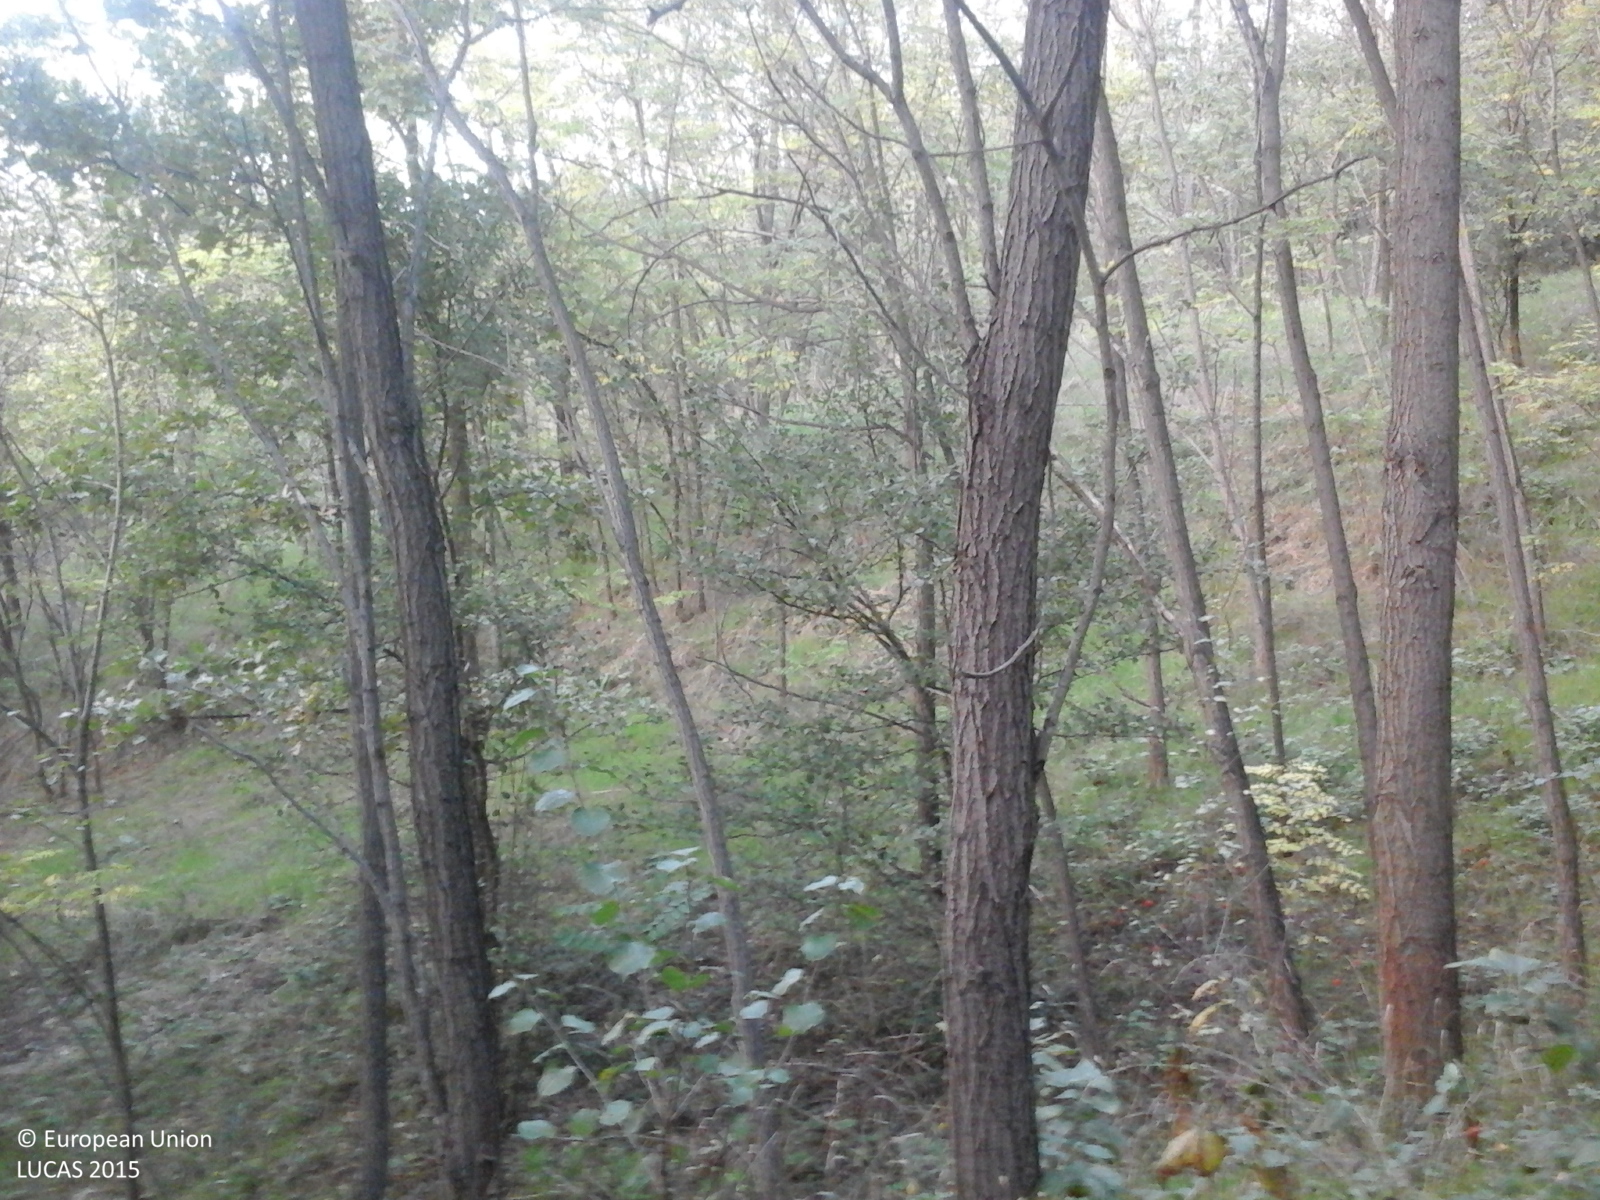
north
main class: Woodland
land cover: Broadleaved woodland
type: exotic forest
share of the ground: > 75 %
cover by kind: broadleaved forest trees 100 %
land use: Forestry
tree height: > 5 m
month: October
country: RO
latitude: 46.5304
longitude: 24.0676
